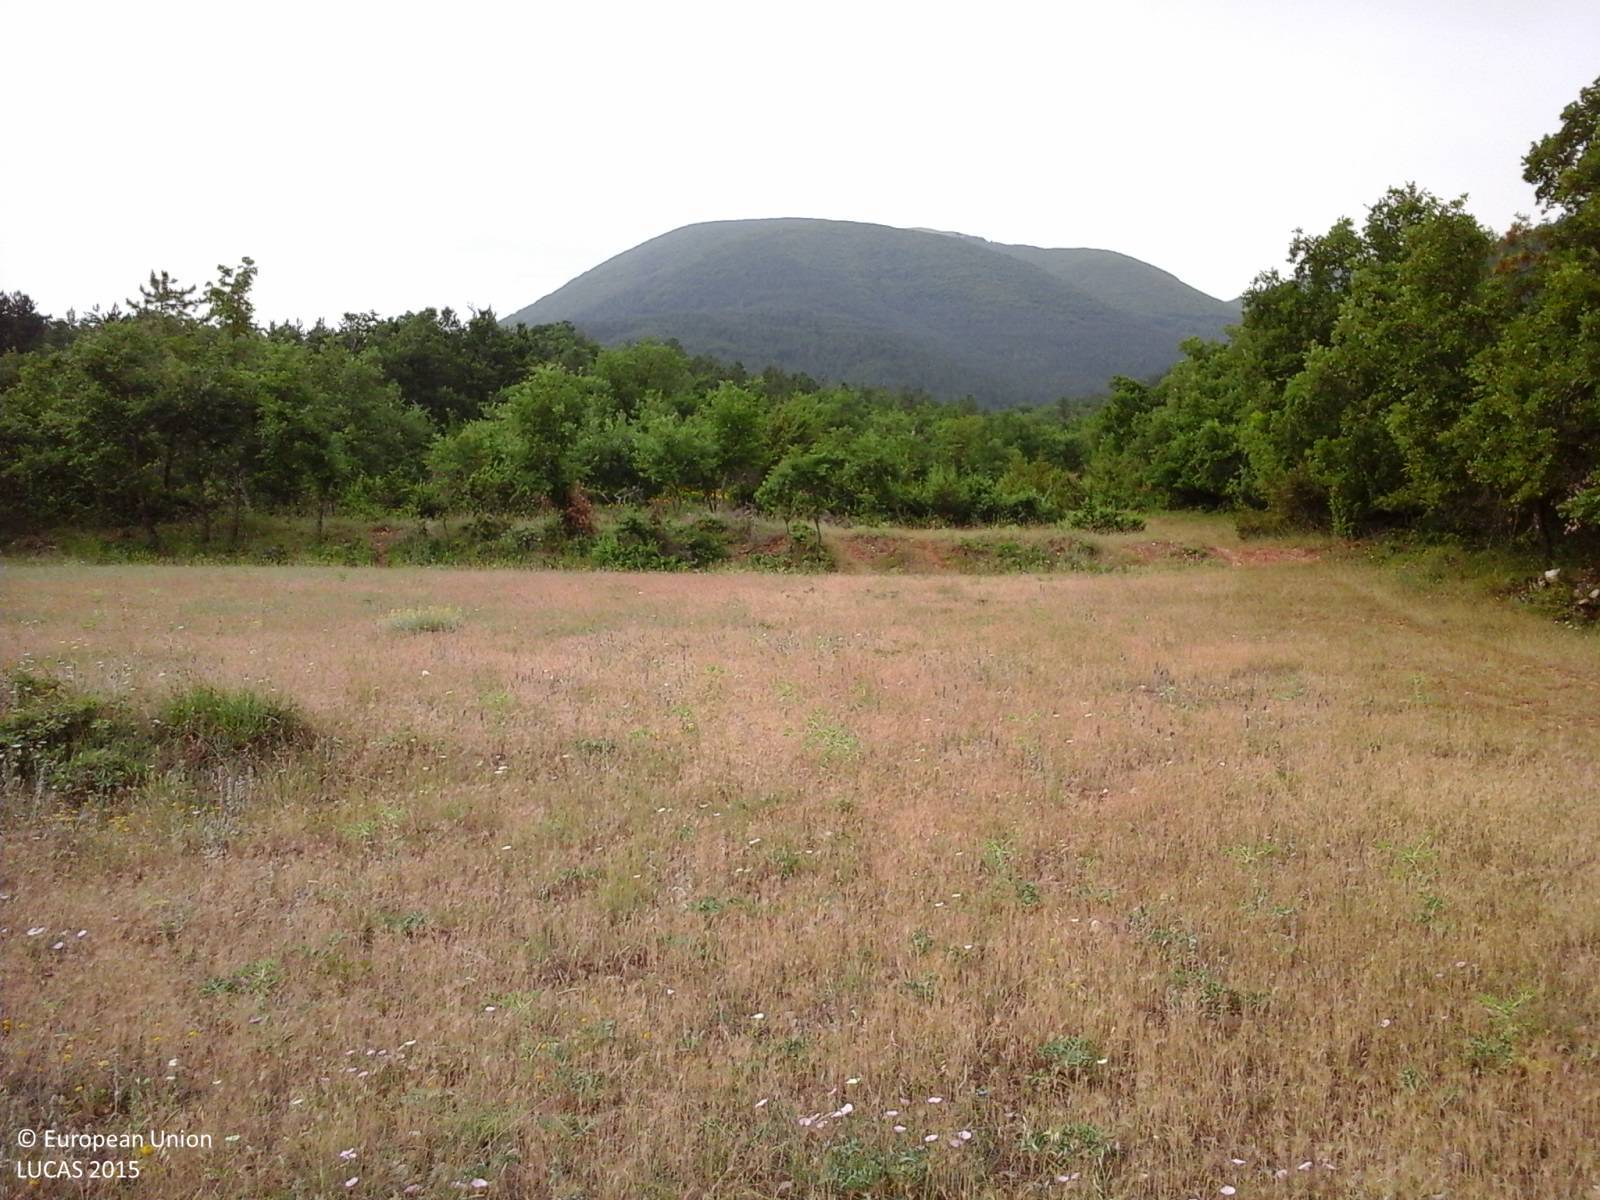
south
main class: Grassland
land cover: Grassland without tree/shrub cover
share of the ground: > 75 %
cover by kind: herbaceous plants 100 %
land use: Agriculture (excluding fallow land and kitchen gardens)
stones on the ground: 25 - 50 %
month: June
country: IT
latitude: 42.0188
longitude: 13.8876
